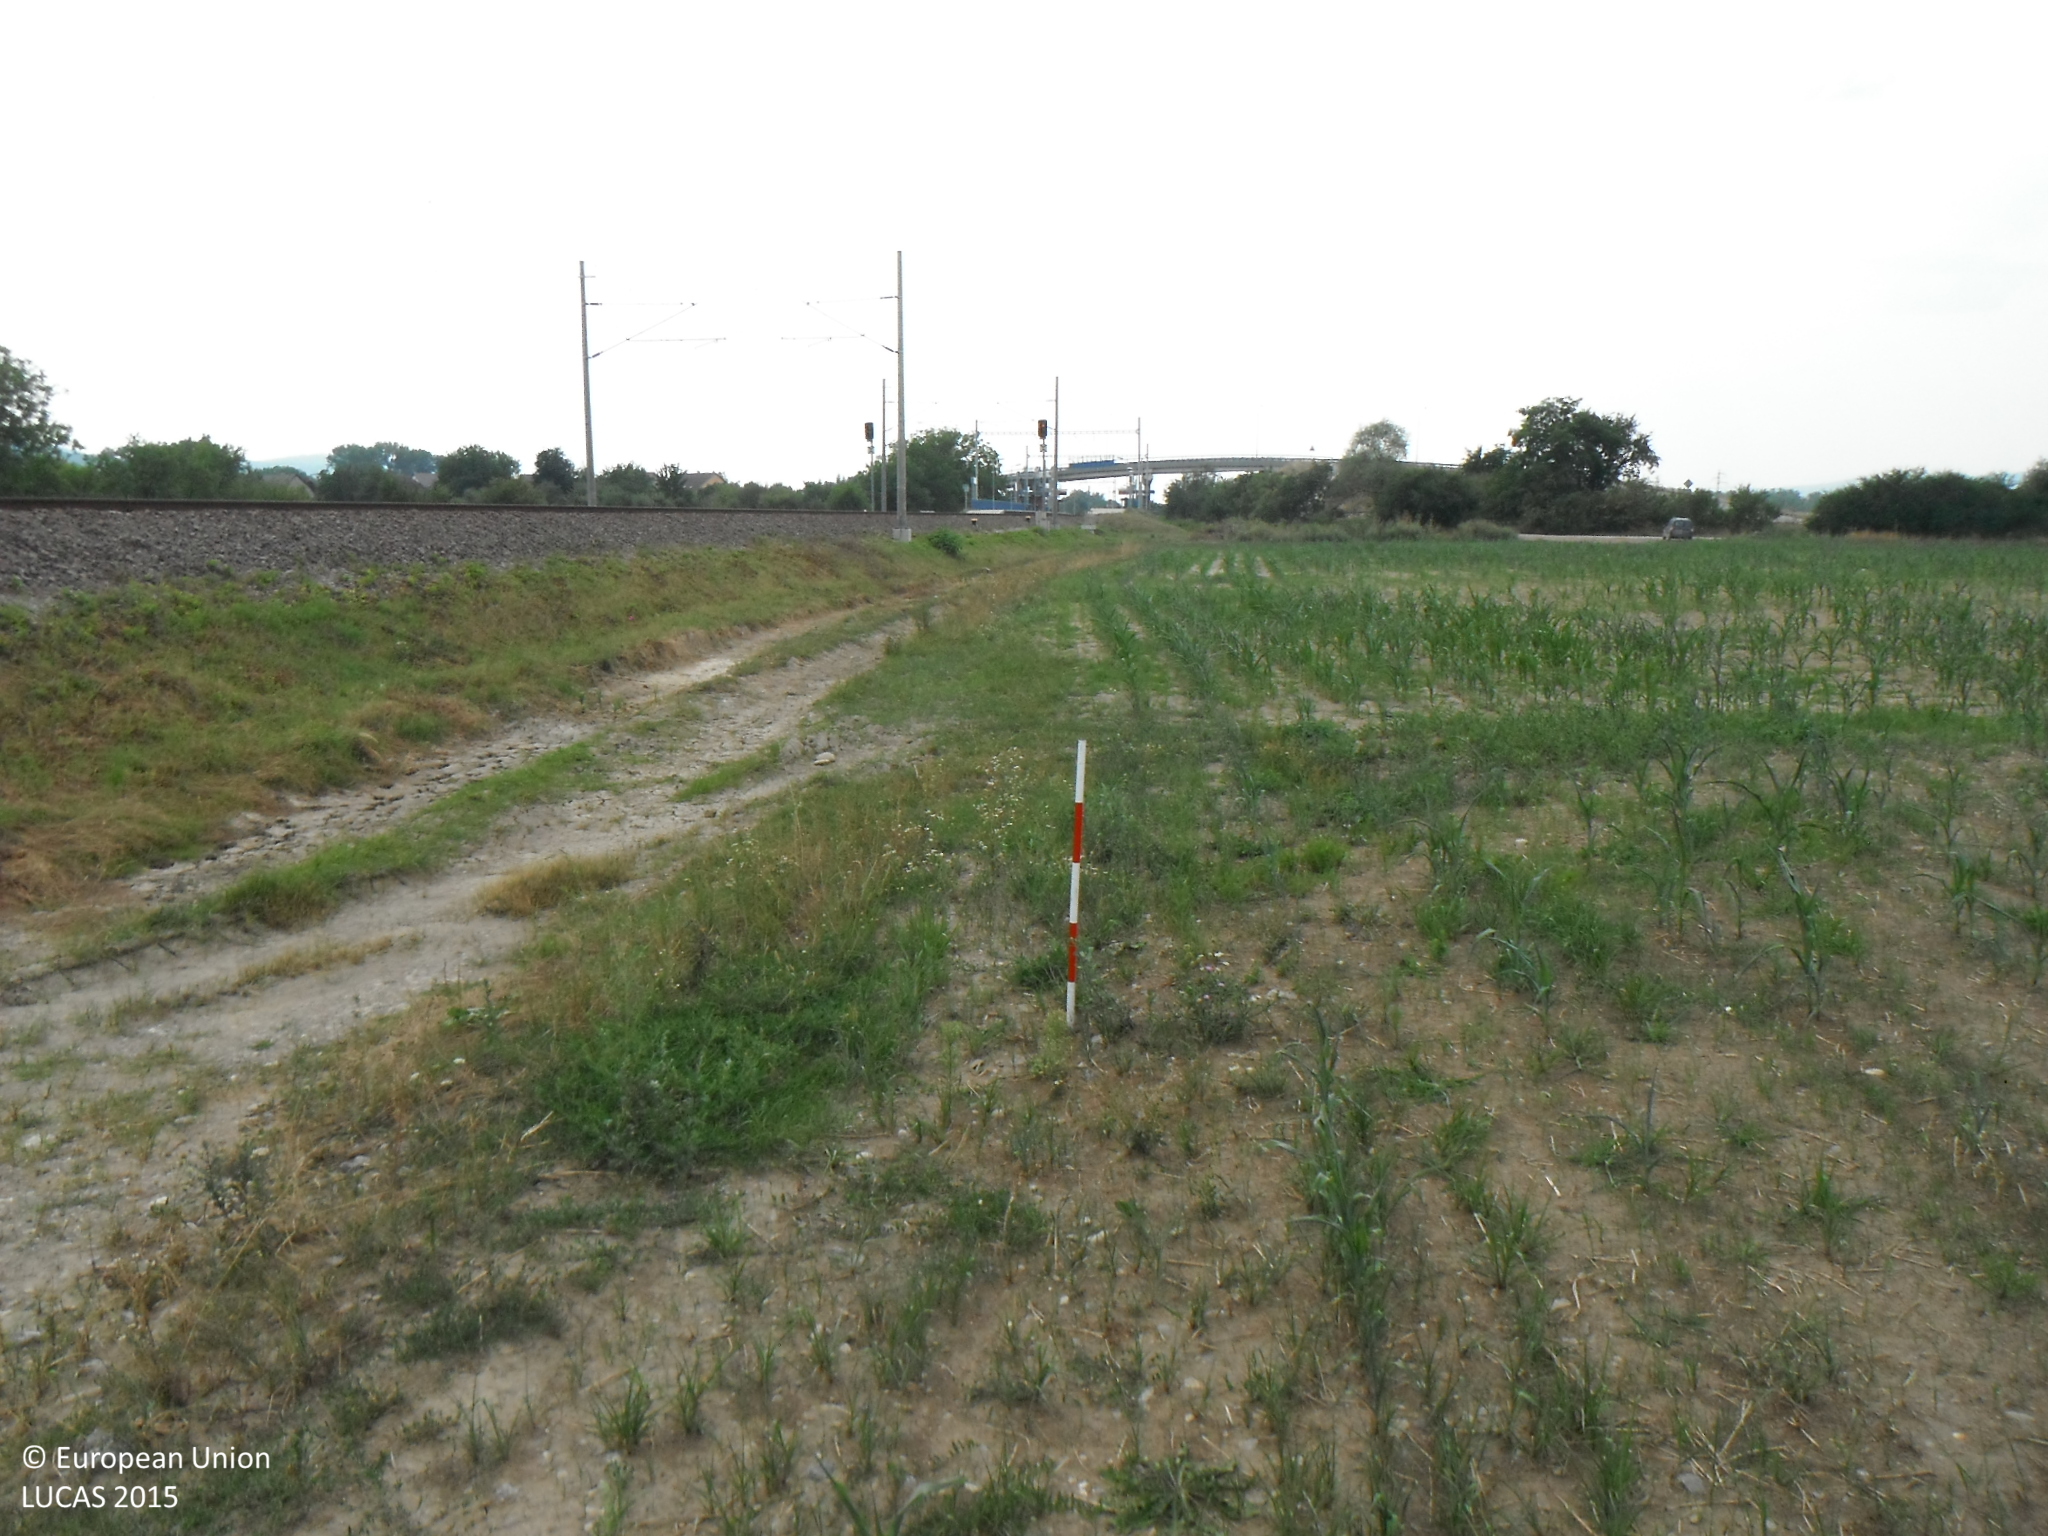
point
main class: Cropland
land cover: Maize
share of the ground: < 10 %
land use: Agriculture (excluding fallow land and kitchen gardens)
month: August
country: SK
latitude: 49.0163
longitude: 18.2611
